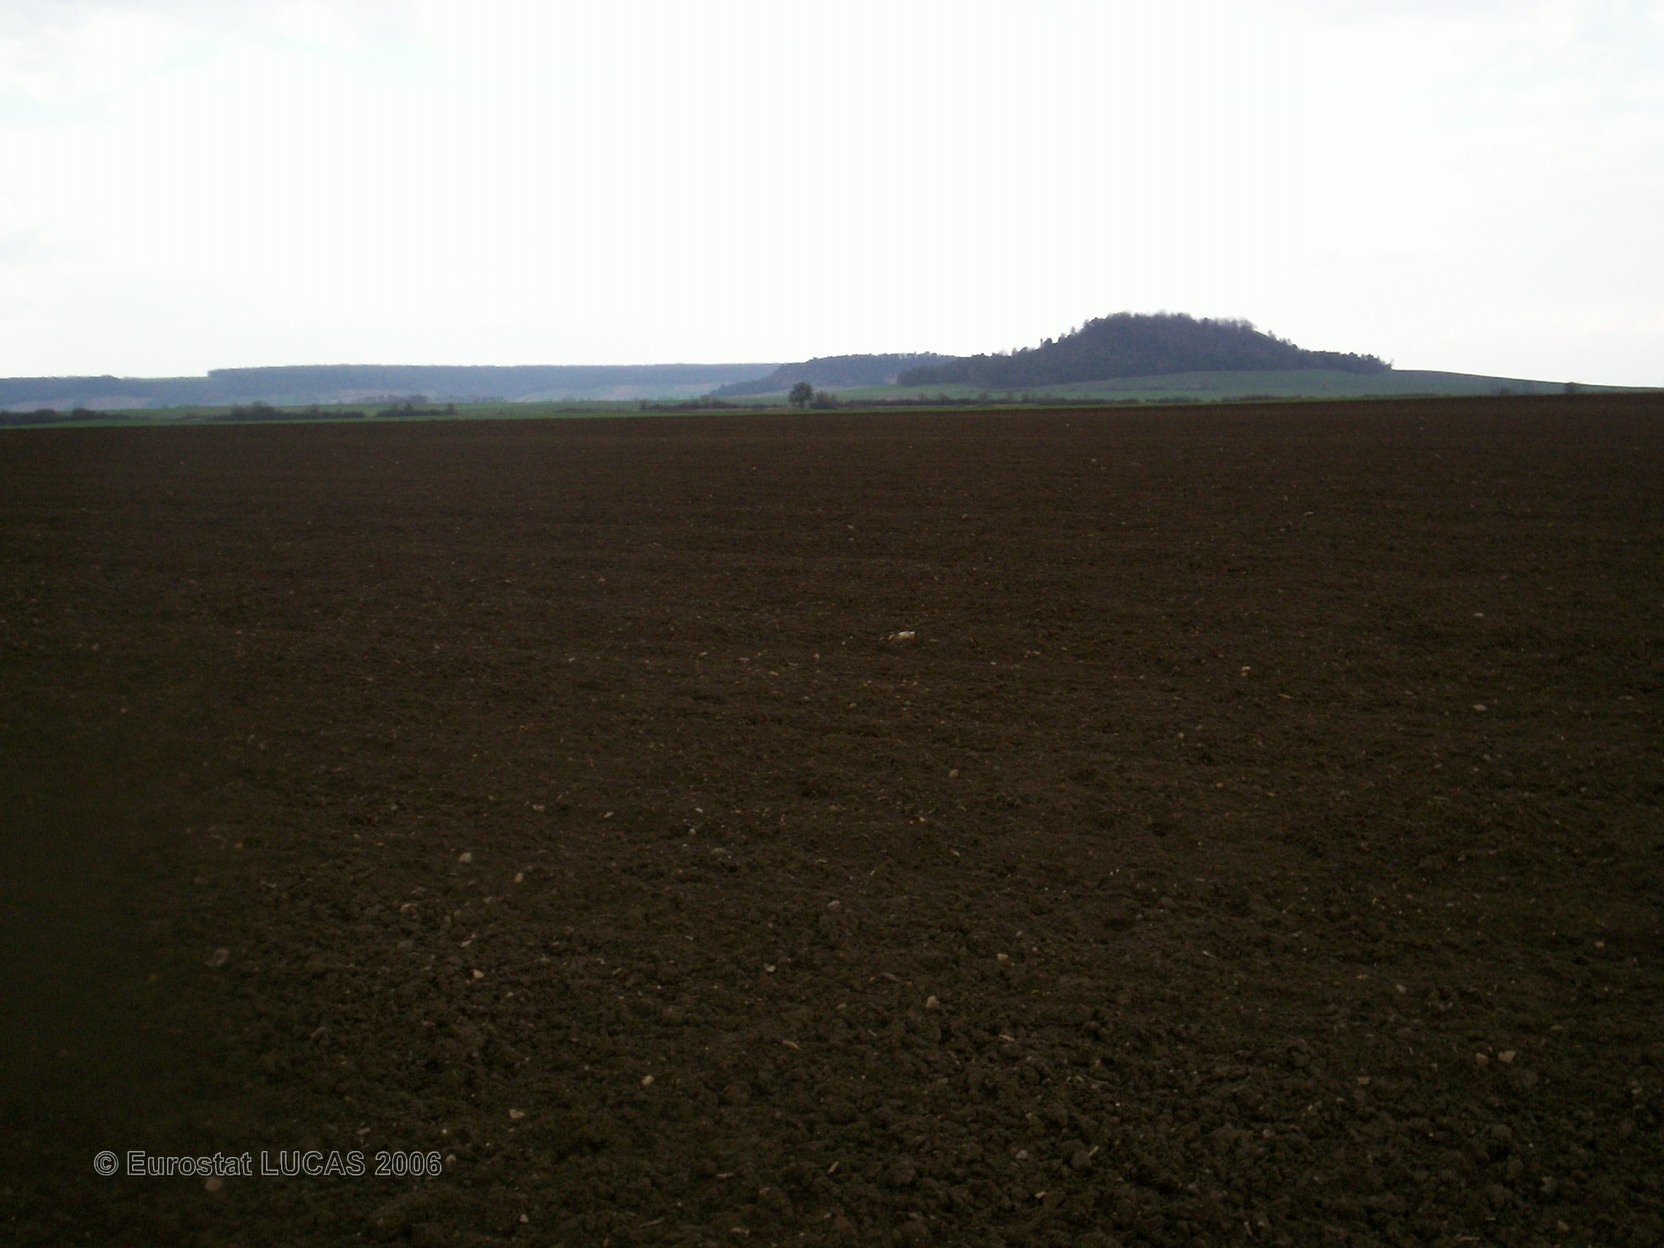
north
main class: Cropland
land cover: Dry pulses
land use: Agriculture (excluding fallow land and kitchen gardens)
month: April
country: FR
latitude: 47.8753
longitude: 4.6103
